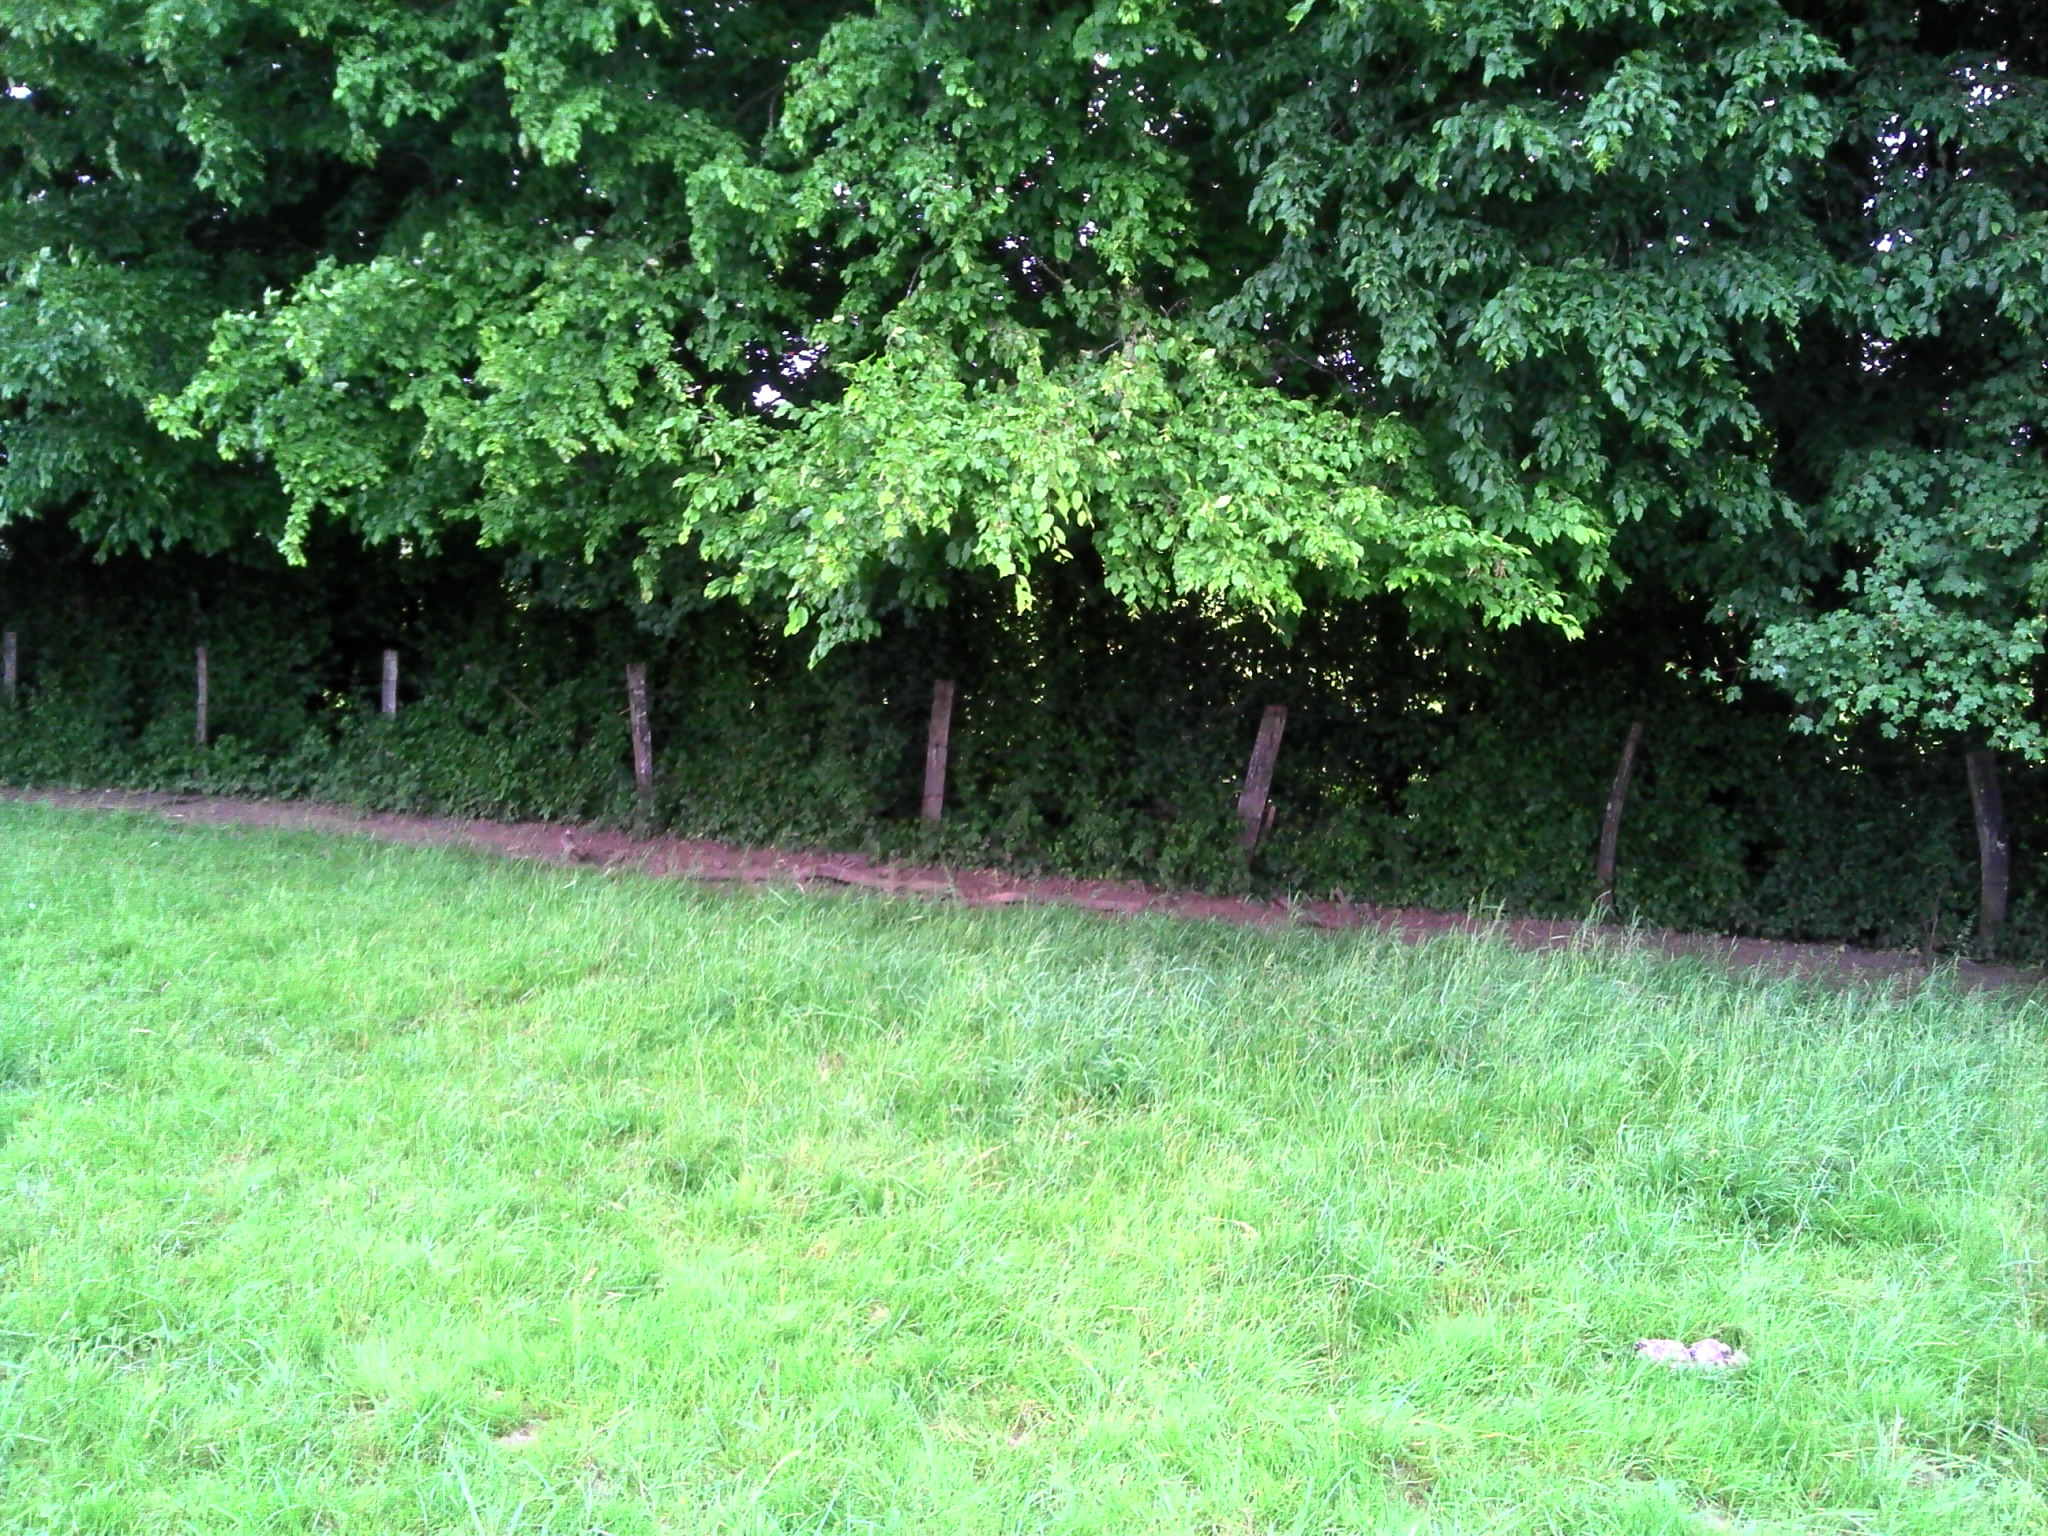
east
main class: Grassland
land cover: Grassland without tree/shrub cover
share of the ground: > 75 %
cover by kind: herbaceous plants 100 %
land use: Agriculture (excluding fallow land and kitchen gardens)
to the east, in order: Grassland without tree/shrub cover; Fences; Broadleaved woodland; Grassland without tree/shrub cover; Fences; Managed hedges; Grassland with sparse tree/shrub cover; Grass margins; Tracks; Grass margins; Broadleaved woodland; Grassland without tree/shrub cover
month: May
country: FR
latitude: 46.5386
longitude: 5.3473
